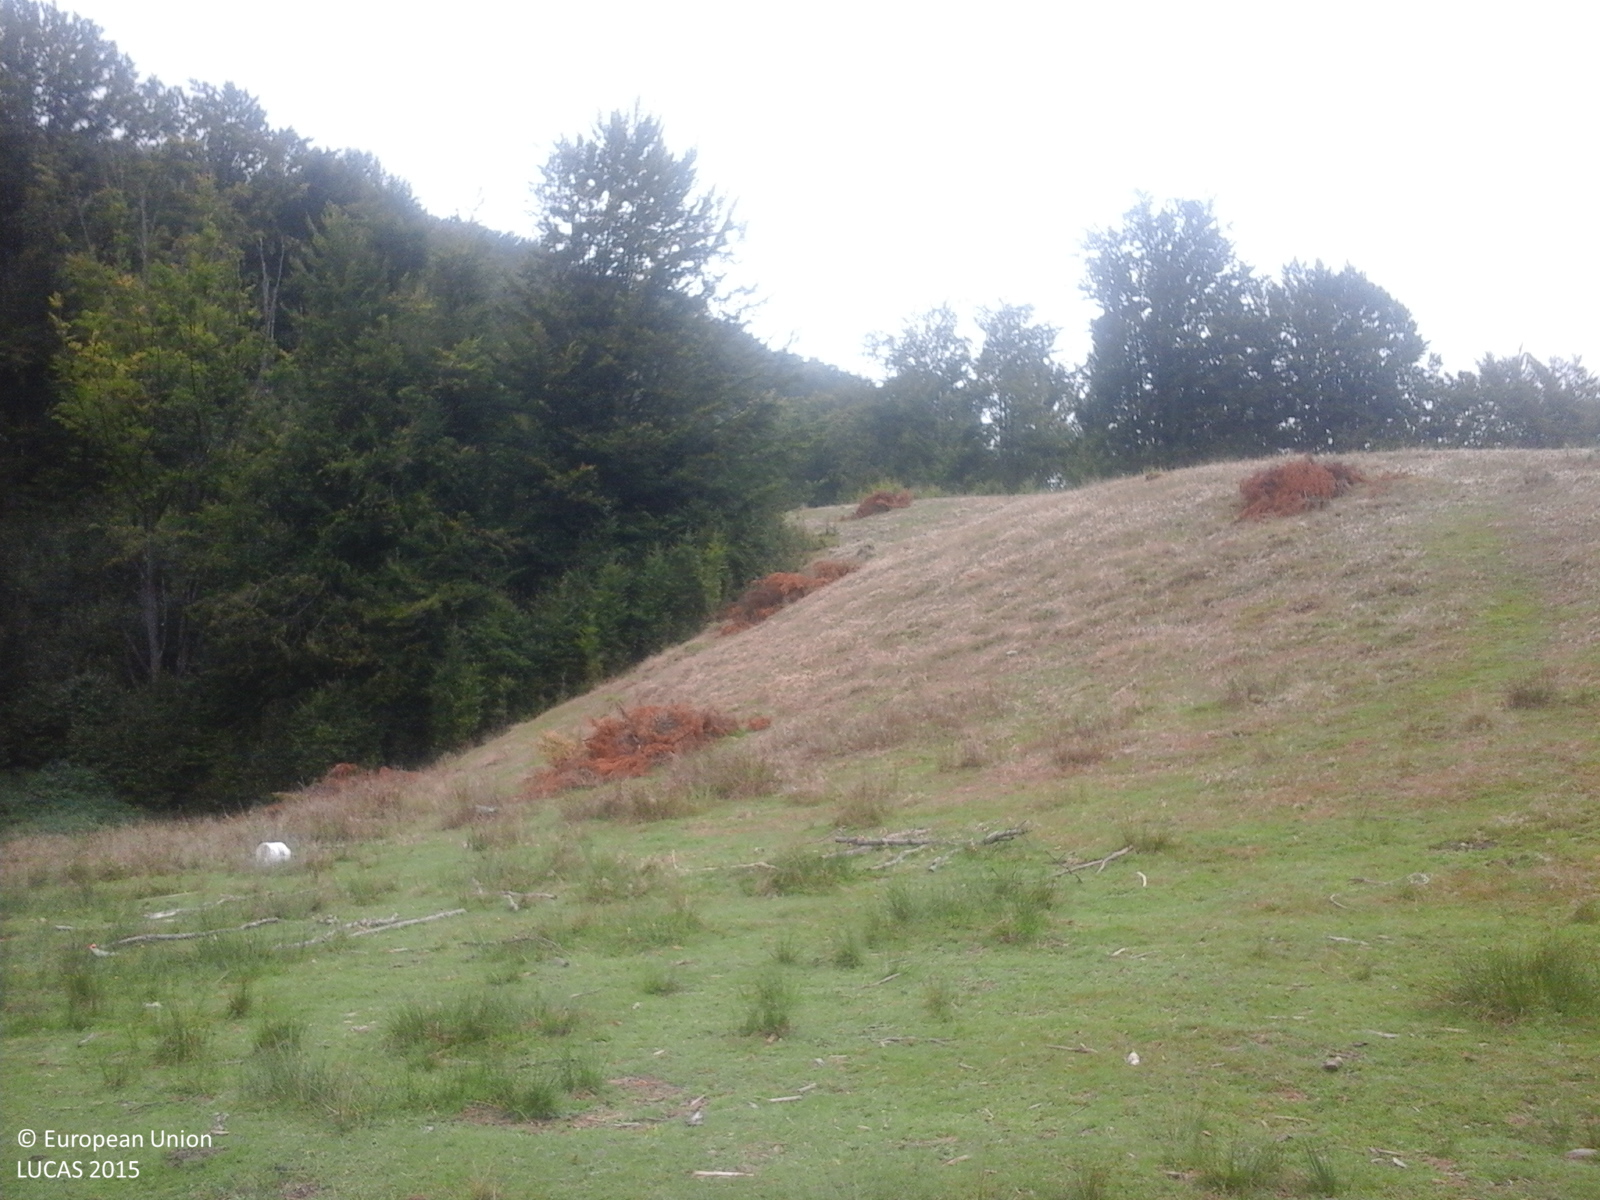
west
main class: Grassland
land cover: Grassland without tree/shrub cover
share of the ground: > 75 %
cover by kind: herbaceous plants 100 %
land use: Agriculture (excluding fallow land and kitchen gardens)
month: September
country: RO
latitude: 46.8563
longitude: 22.4740
